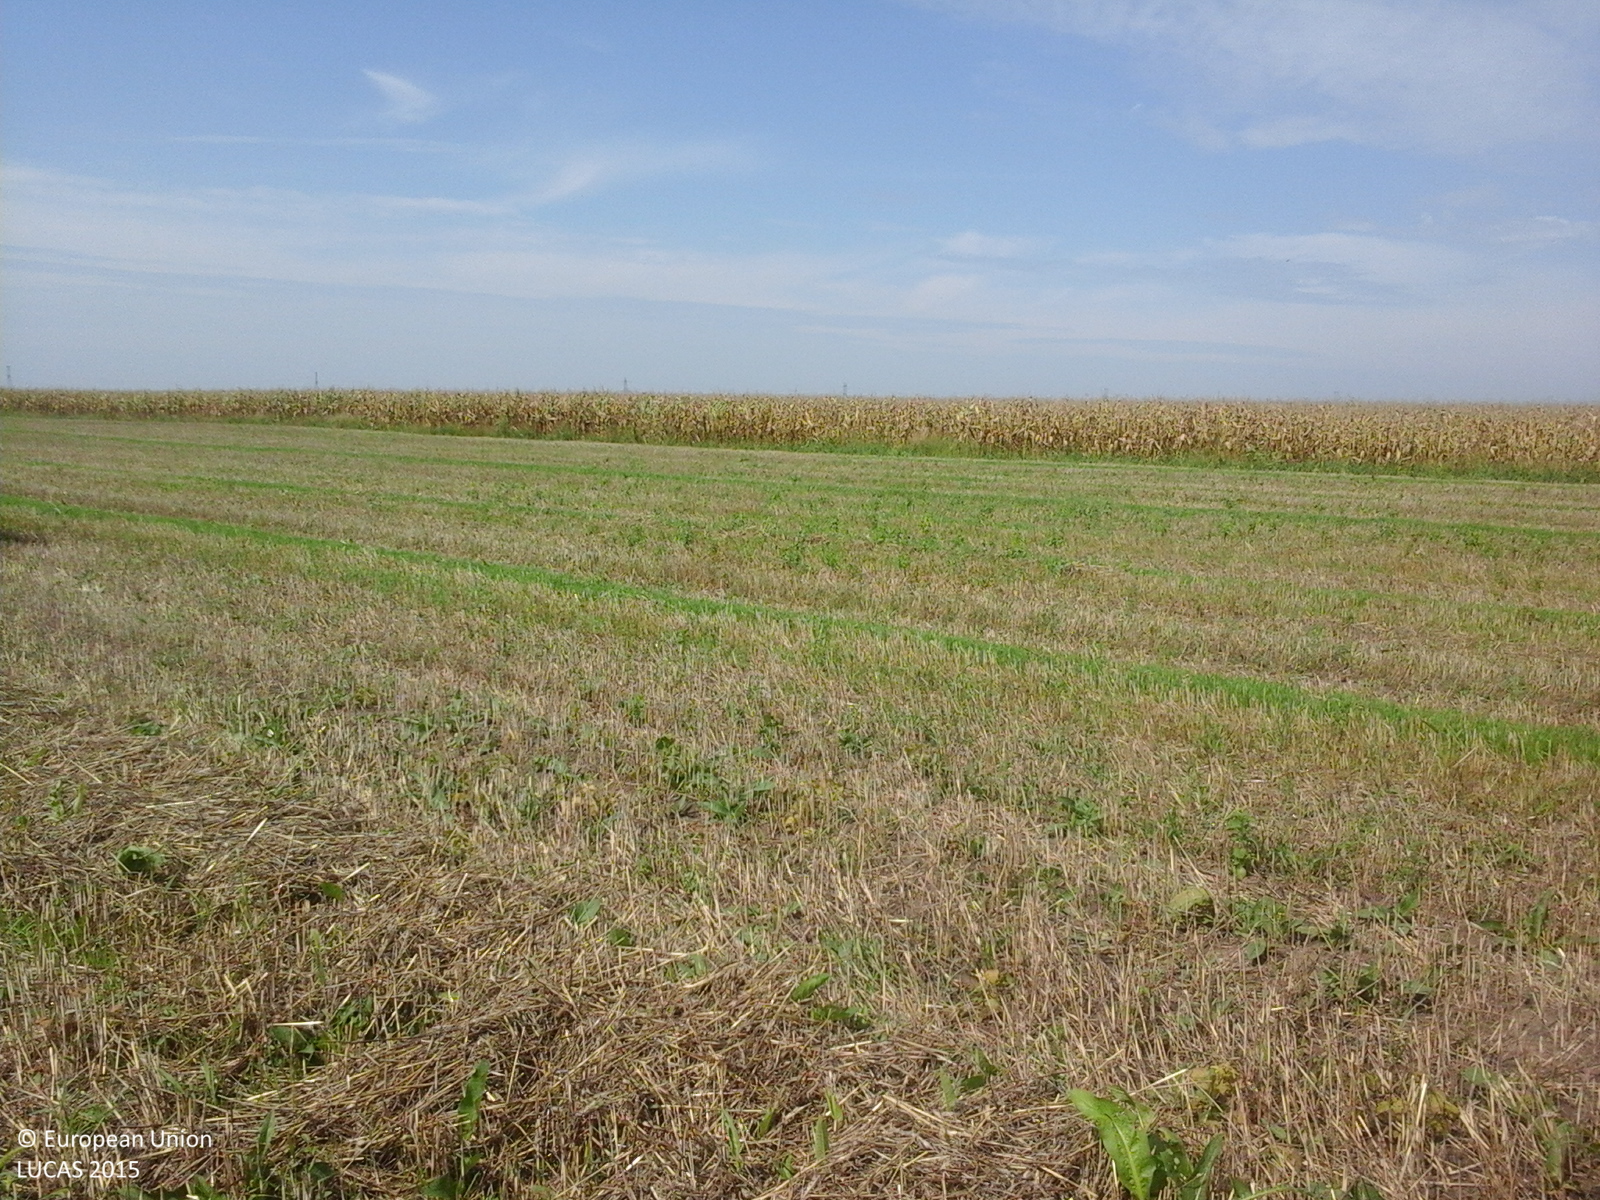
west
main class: Cropland
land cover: Maize
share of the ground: > 75 %
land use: Agriculture (excluding fallow land and kitchen gardens)
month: August
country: RO
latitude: 46.3814
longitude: 21.5182
